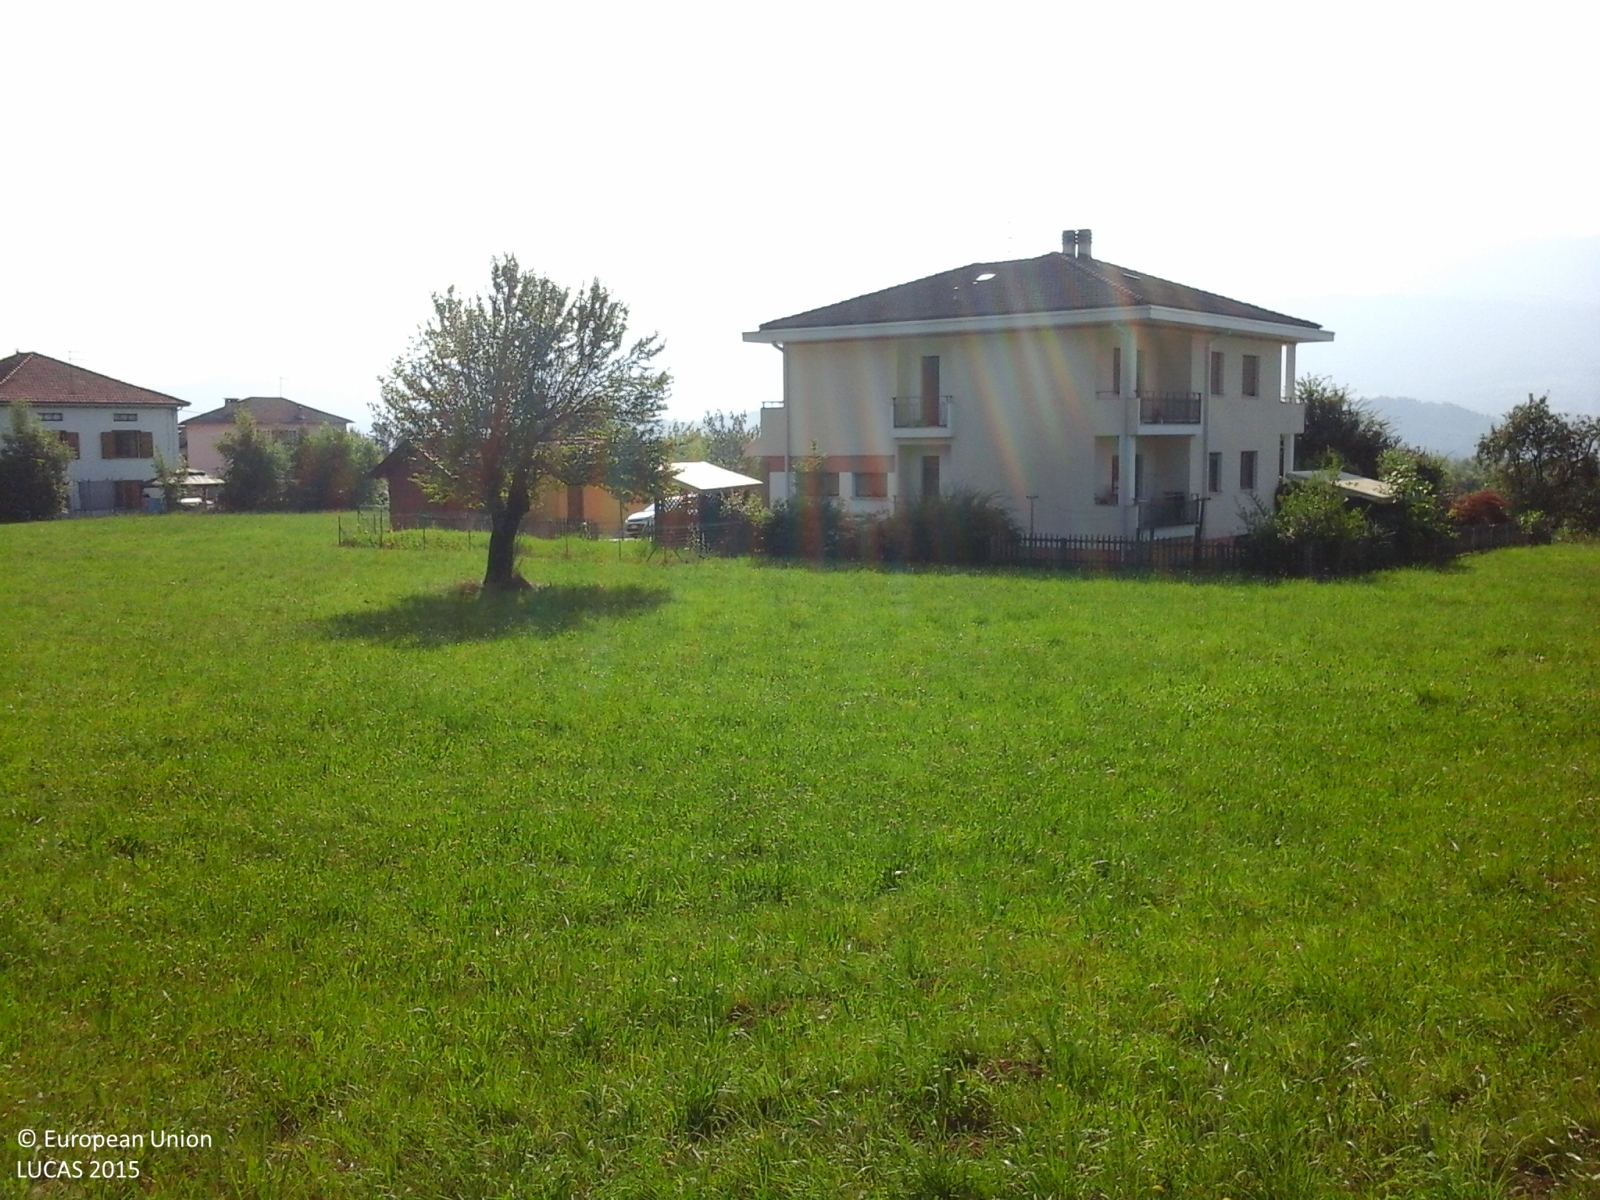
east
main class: Grassland
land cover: Grassland without tree/shrub cover
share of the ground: > 75 %
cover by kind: herbaceous plants 100 %
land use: Agriculture (excluding fallow land and kitchen gardens)
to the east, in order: Grassland without tree/shrub cover; Artificial constructions in urban areas; Grassland without tree/shrub cover; Managed hedges; Fences; Paved roads, cycling and walking lanes; Broadleaved woodland; Grassland with sparse tree/shrub cover; Apple fruit; Grassland without tree/shrub cover; Grassland with sparse tree/shrub cover; Vineyards; Grassland without tree/shrub cover; Vineyards; Grassland without tree/shrub cover
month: July
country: IT
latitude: 46.1307
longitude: 12.1846
